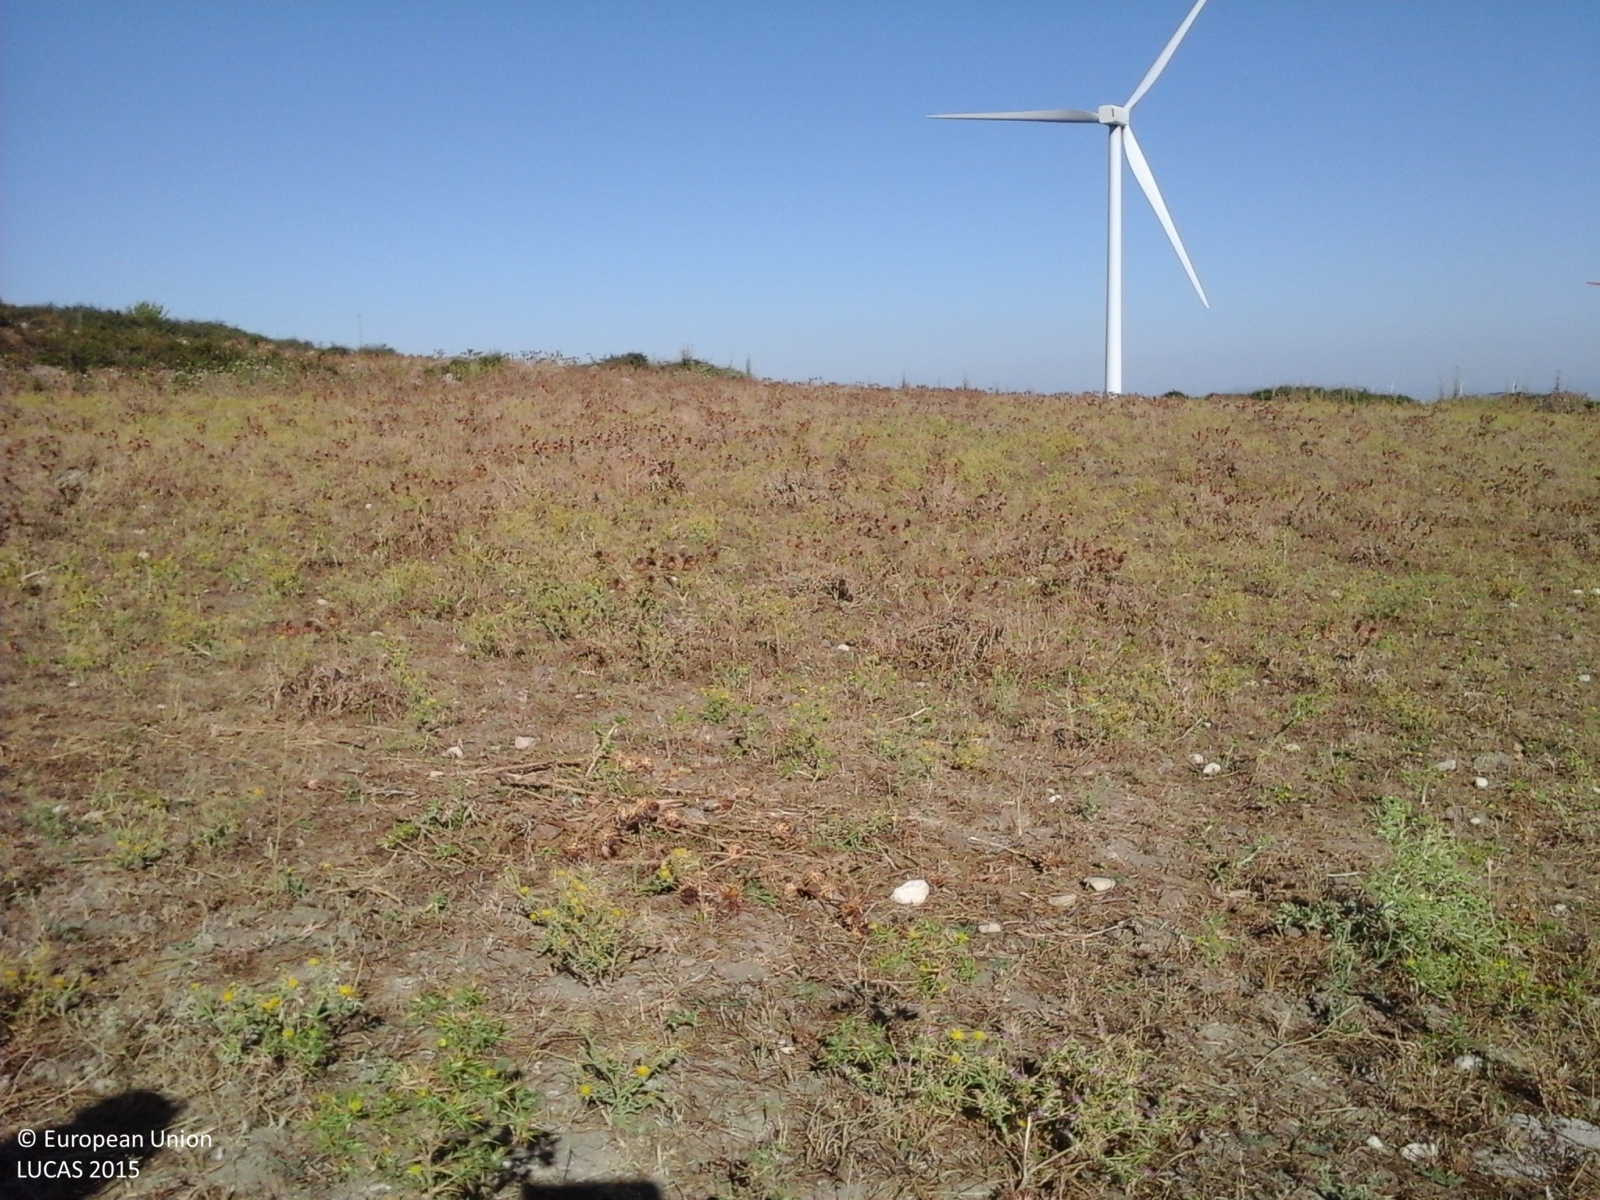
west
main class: Cropland
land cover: Mixed cereals for fodder
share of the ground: > 75 %
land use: Agriculture (excluding fallow land and kitchen gardens)
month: July
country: IT
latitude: 37.1175
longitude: 14.7912
